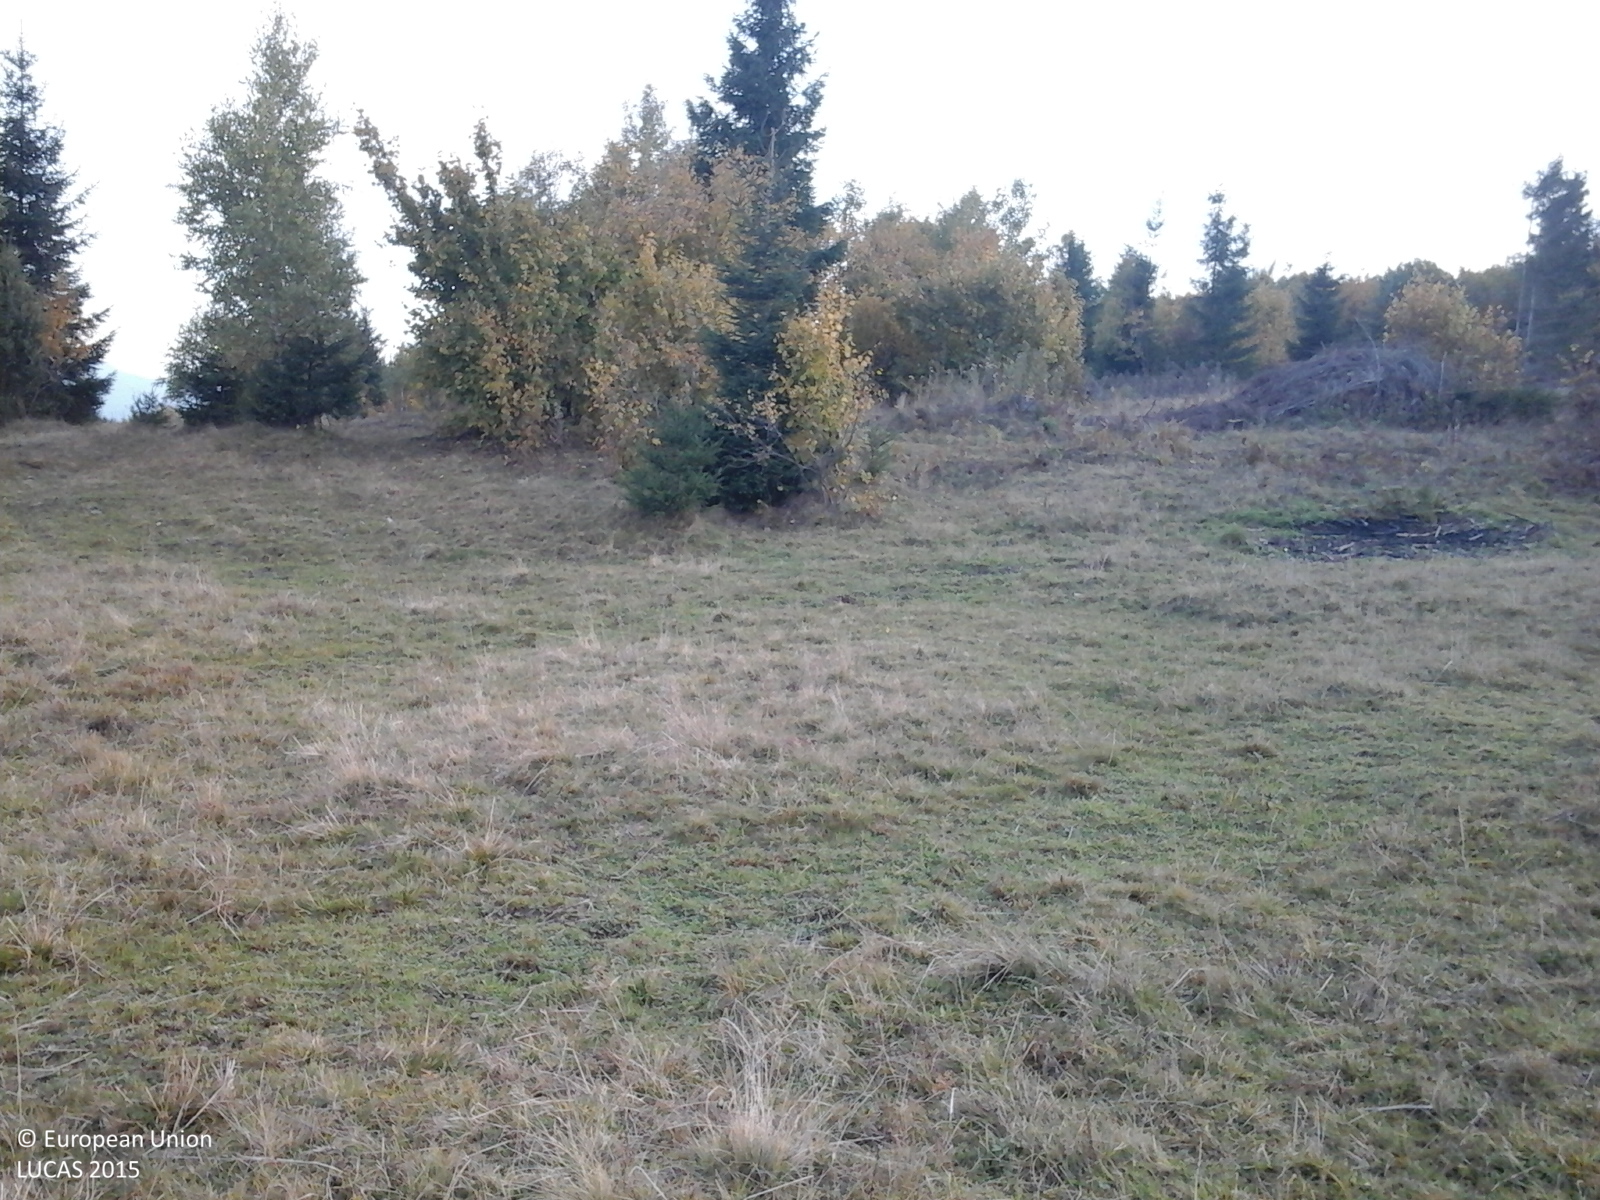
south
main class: Grassland
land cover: Grassland without tree/shrub cover
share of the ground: > 75 %
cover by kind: herbaceous plants 100 %
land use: Agriculture (excluding fallow land and kitchen gardens)
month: October
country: RO
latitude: 46.7154
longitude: 25.3741
